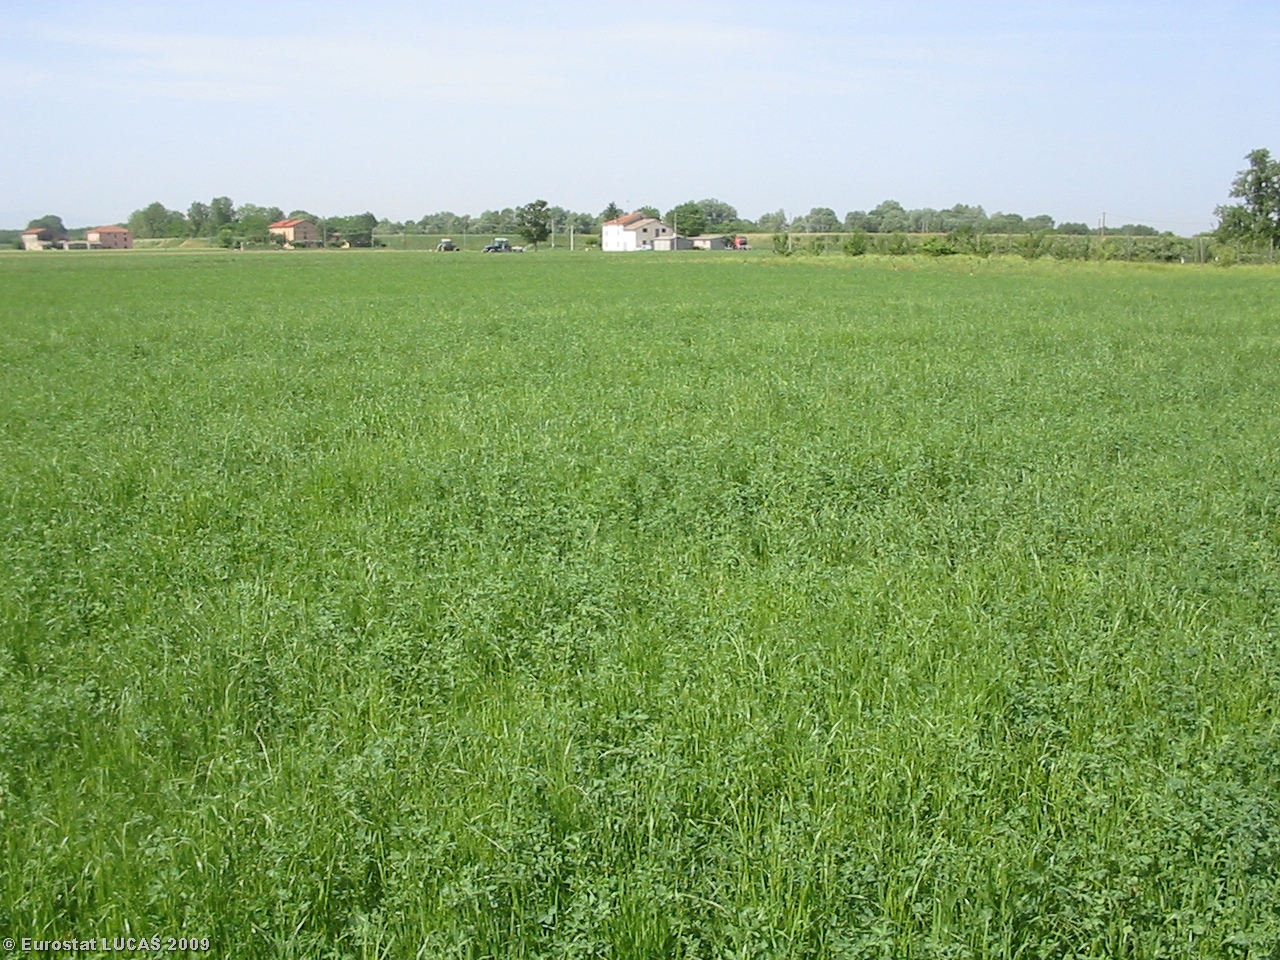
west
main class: Cropland
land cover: Lucerne
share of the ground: > 75 %
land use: Agriculture (excluding fallow land and kitchen gardens)
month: May
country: IT
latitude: 44.8730
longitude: 10.3411
